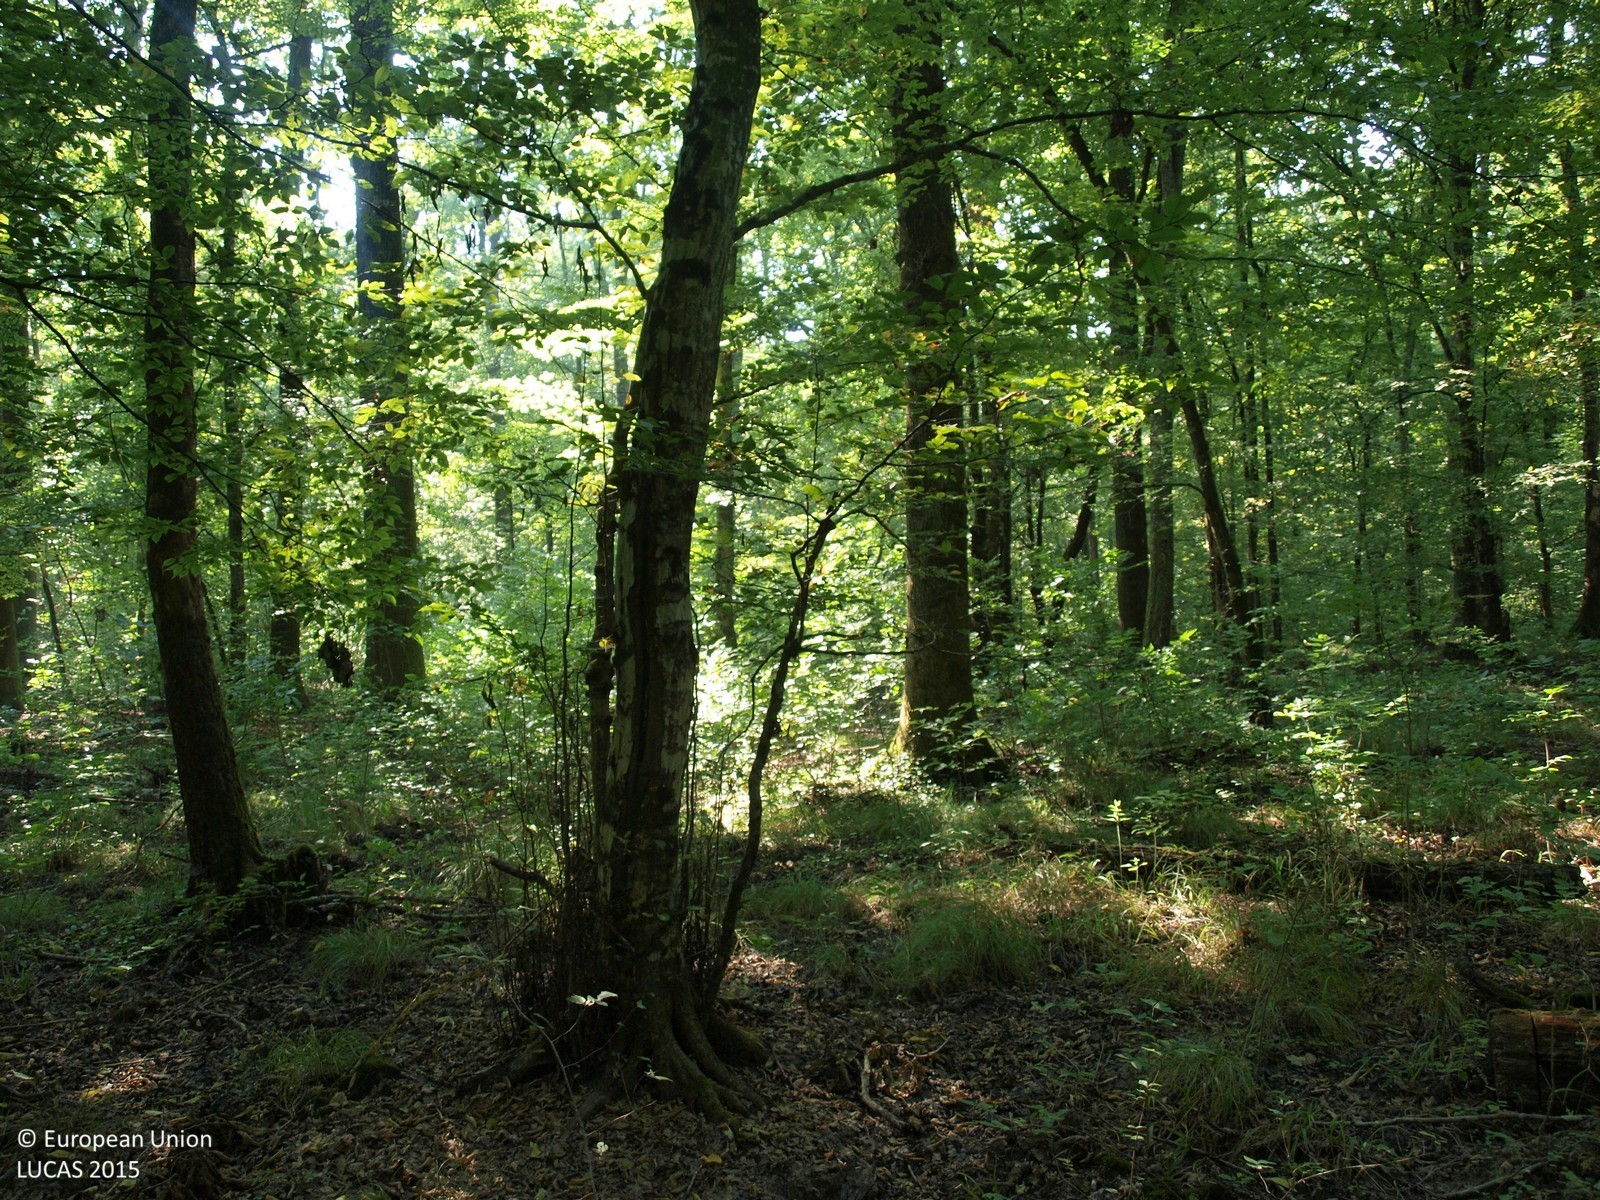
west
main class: Woodland
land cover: Broadleaved woodland
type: floodplain forest
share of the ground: > 75 %
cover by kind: broadleaved forest trees 100 %
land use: Forestry
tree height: > 5 m
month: August
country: HR
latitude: 45.6145
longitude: 16.4487
